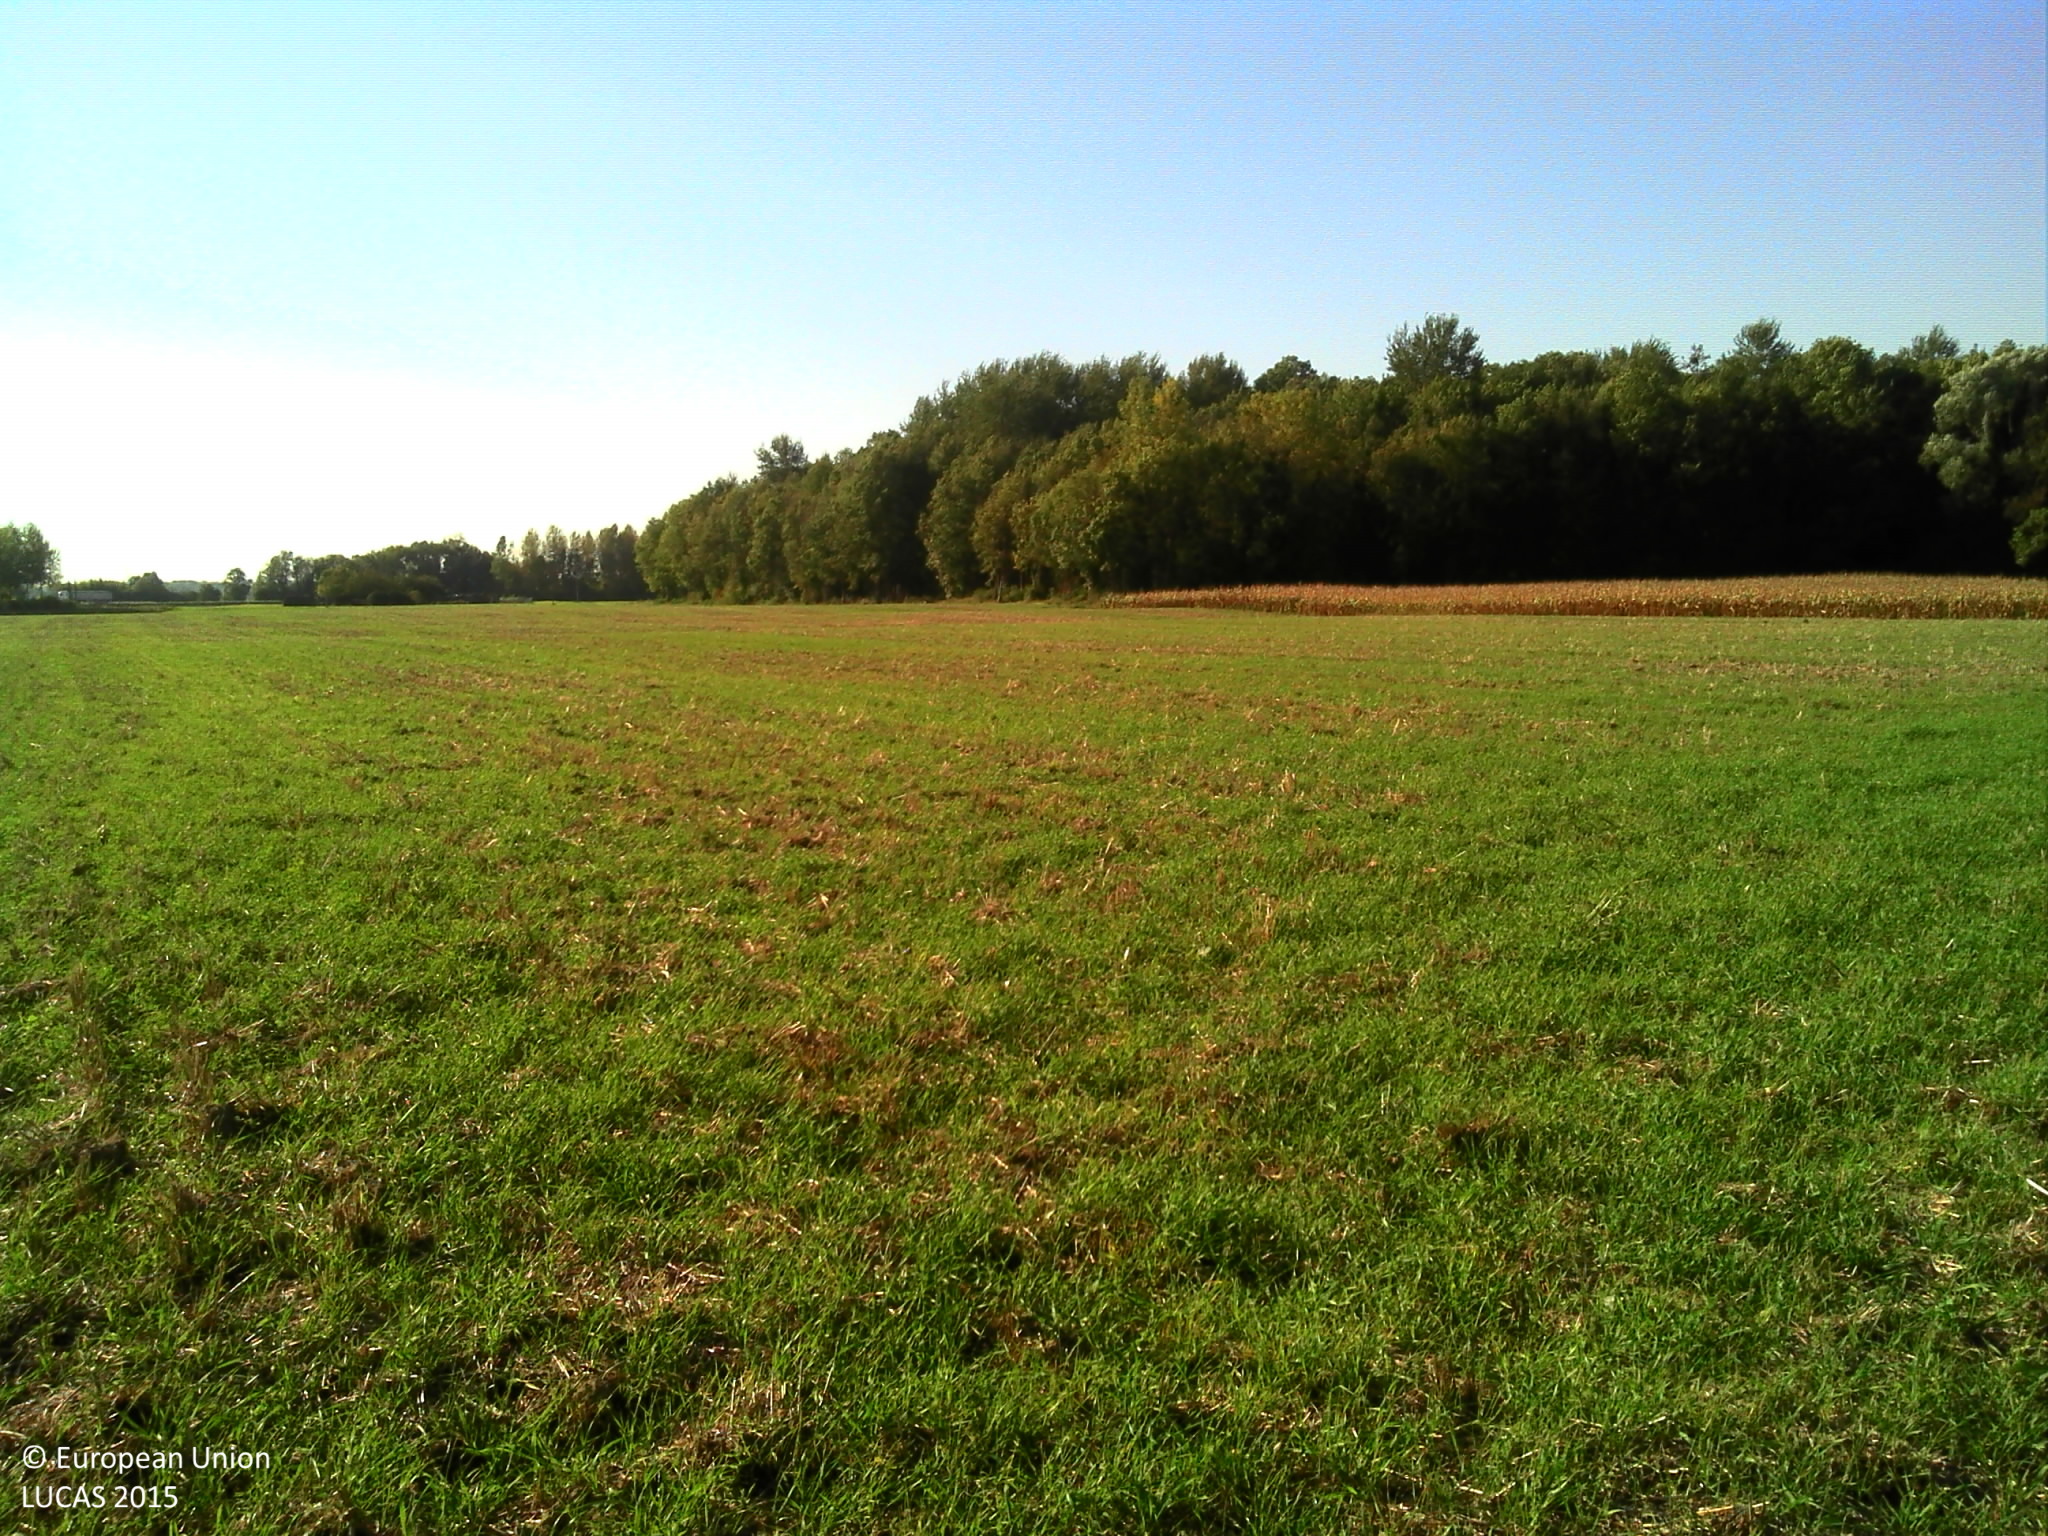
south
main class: Cropland
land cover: Common wheat
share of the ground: < 10 %
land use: Agriculture (excluding fallow land and kitchen gardens)
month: September
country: FR
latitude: 48.4579
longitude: 3.3811
